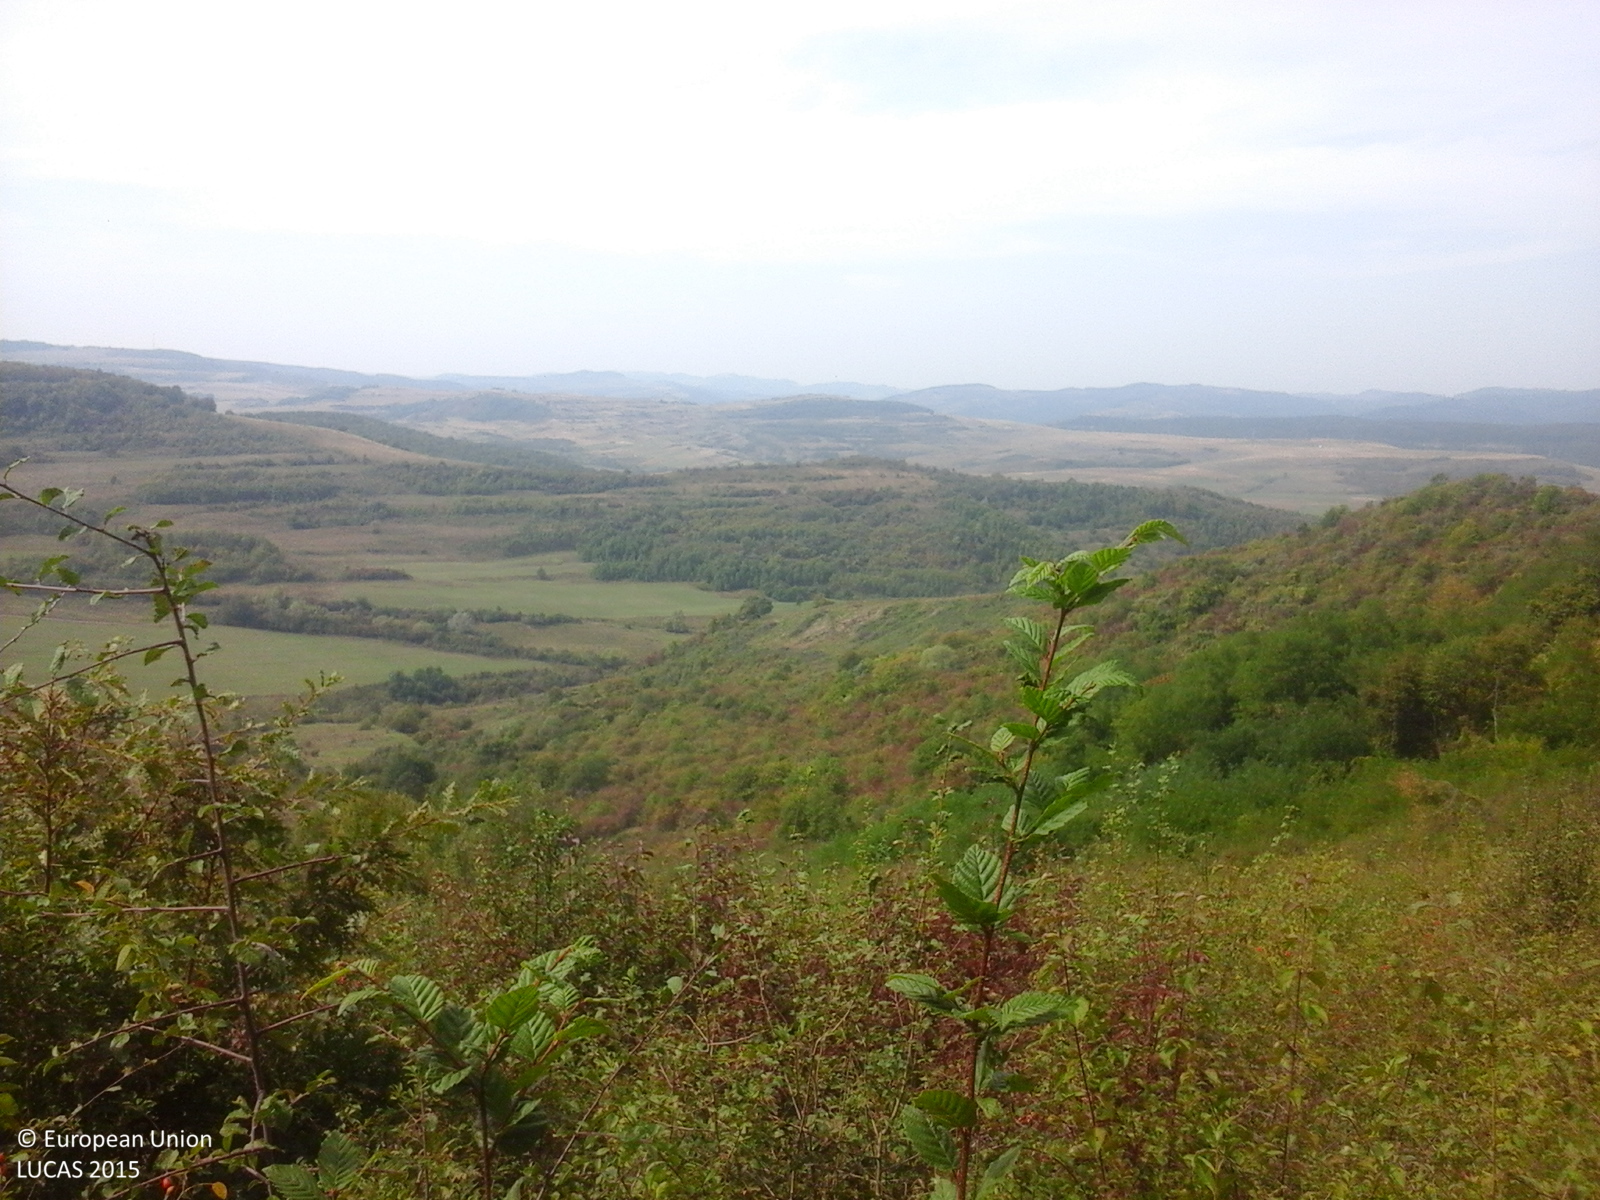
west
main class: Shrubland
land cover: Shrubland with sparse tree cover
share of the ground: > 75 %
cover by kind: shrubs 95 %, broadleaved forest trees 5 %
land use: Forestry
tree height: < 5 m
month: September
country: RO
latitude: 47.1832
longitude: 23.6805
